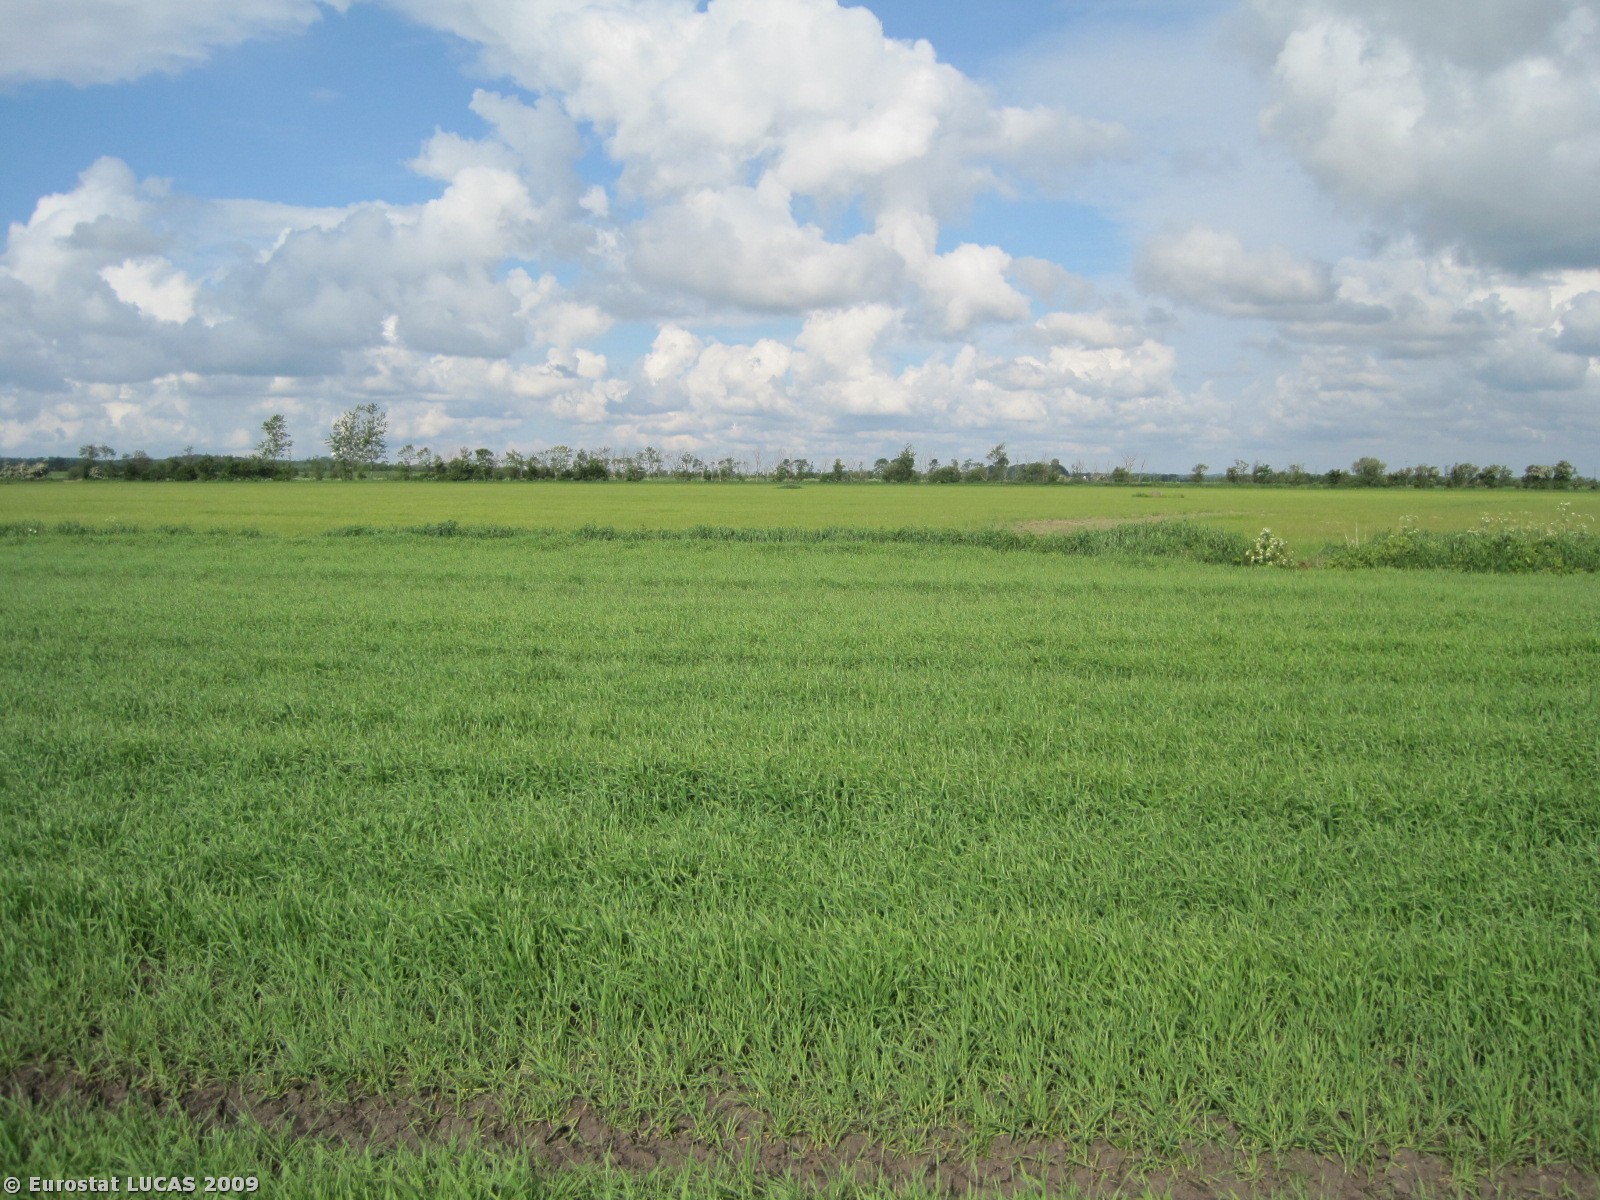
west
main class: Cropland
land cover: Barley
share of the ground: > 75 %
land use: Agriculture (excluding fallow land and kitchen gardens)
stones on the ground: < 10 %
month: June
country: DK
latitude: 57.1044
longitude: 10.2143
